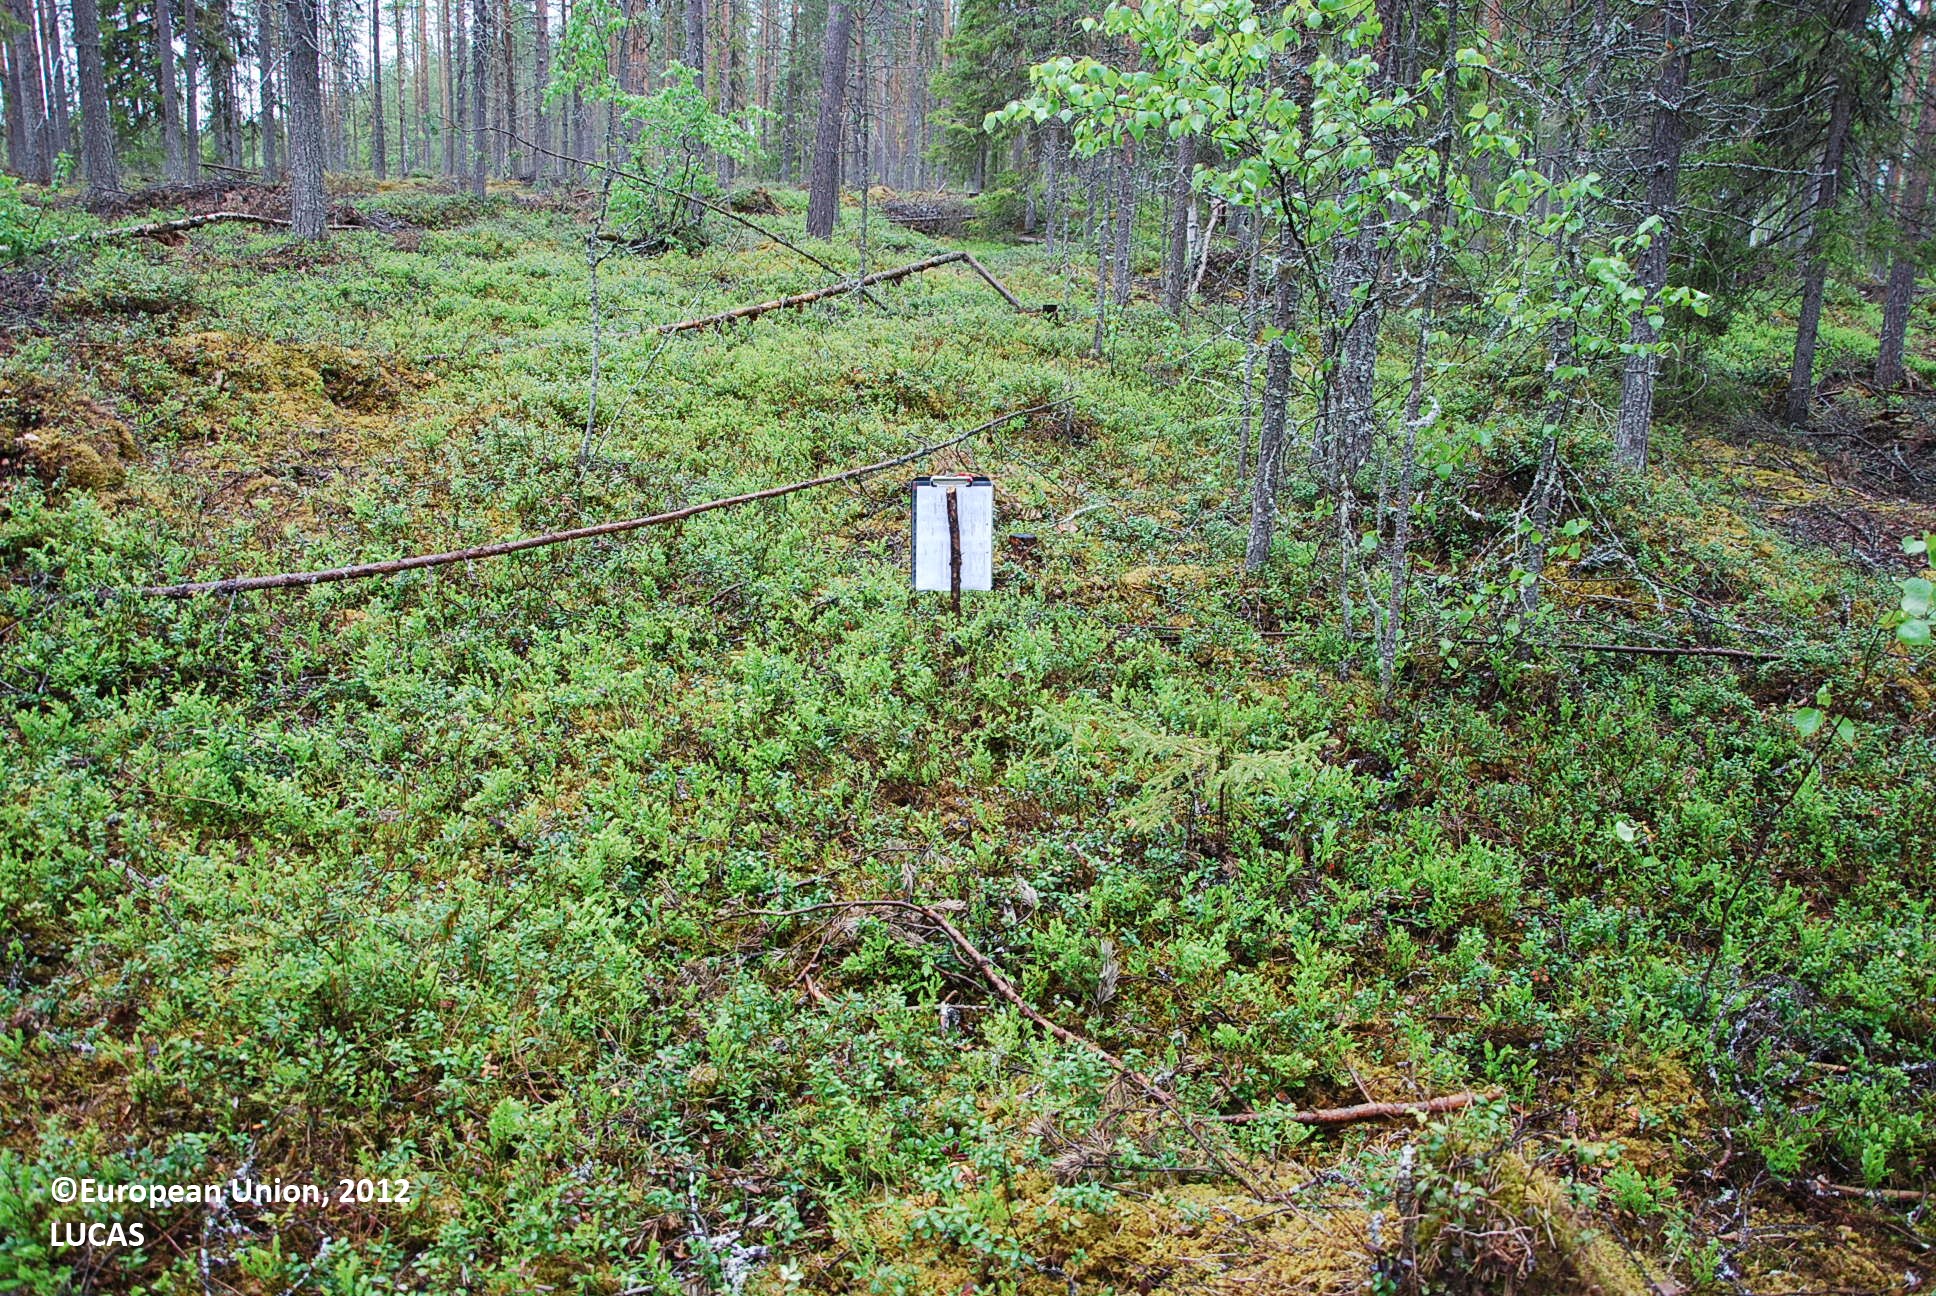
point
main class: Woodland
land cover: Other coniferous woodland
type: boreal forest
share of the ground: > 75 %
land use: Forestry
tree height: > 5 m
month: June
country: FI
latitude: 66.2647
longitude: 26.9565
